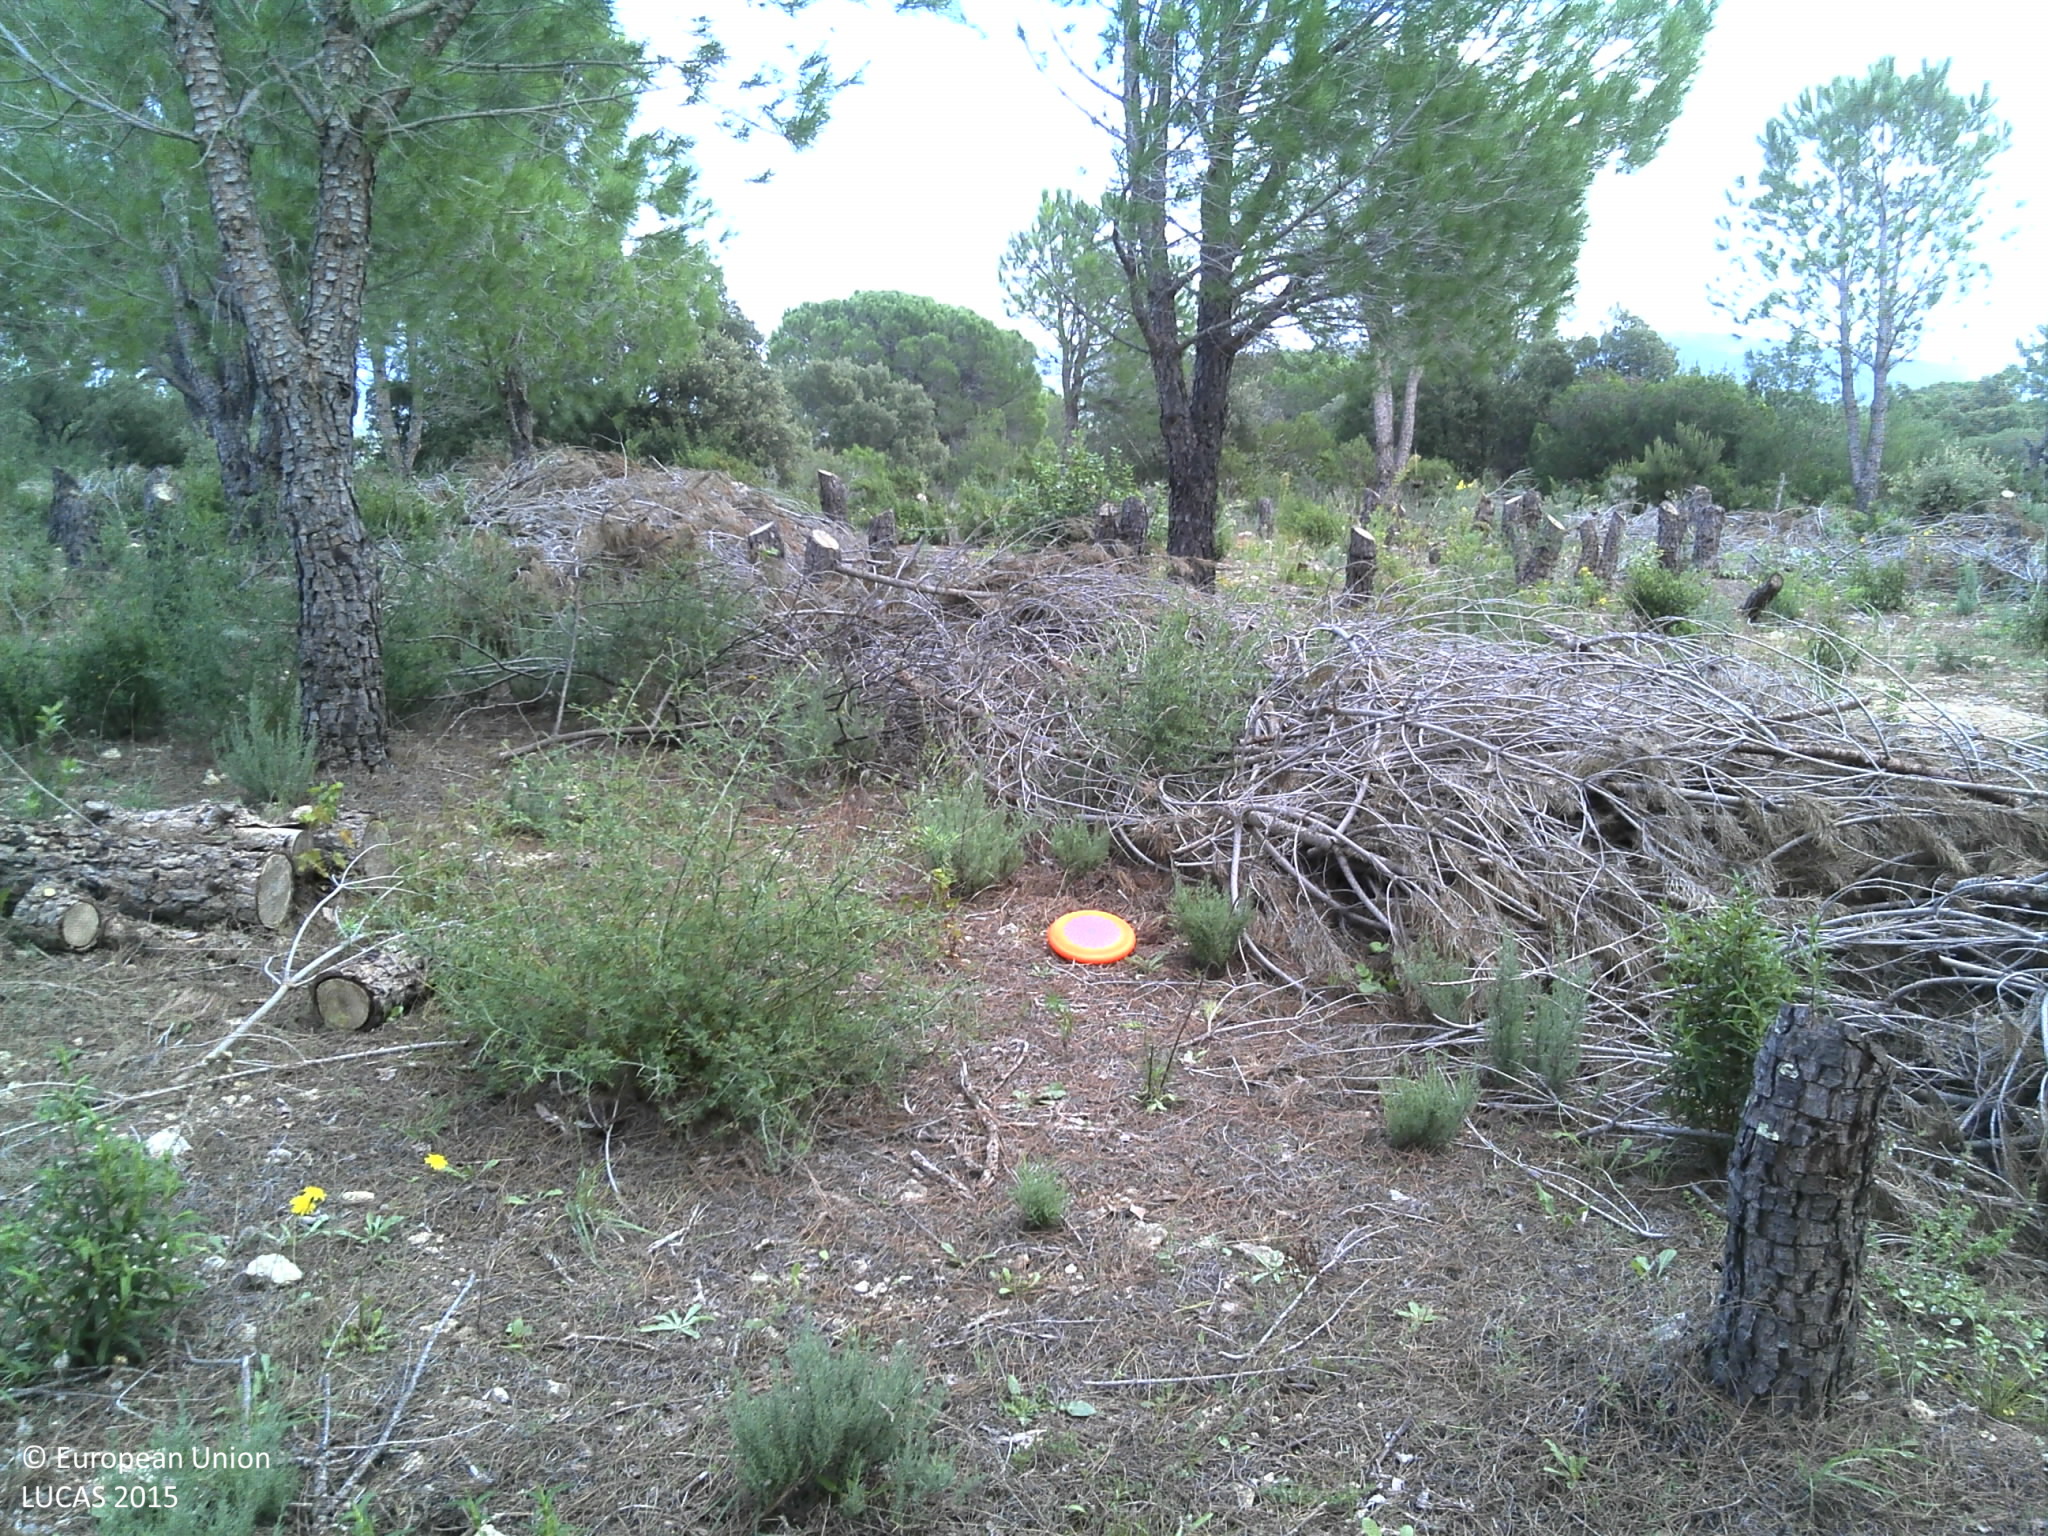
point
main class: Woodland
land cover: Pine dominated coniferous woodland
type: coniferous forest of the mediterranean region
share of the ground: 50 - 75 %
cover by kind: coniferous forest trees 50 %, unconsolidated bare surface 30 %, shrubs 10 %, herbaceous plants 5 %
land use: Forestry
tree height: > 5 m
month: October
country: FR
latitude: 43.3359
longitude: 6.5429
